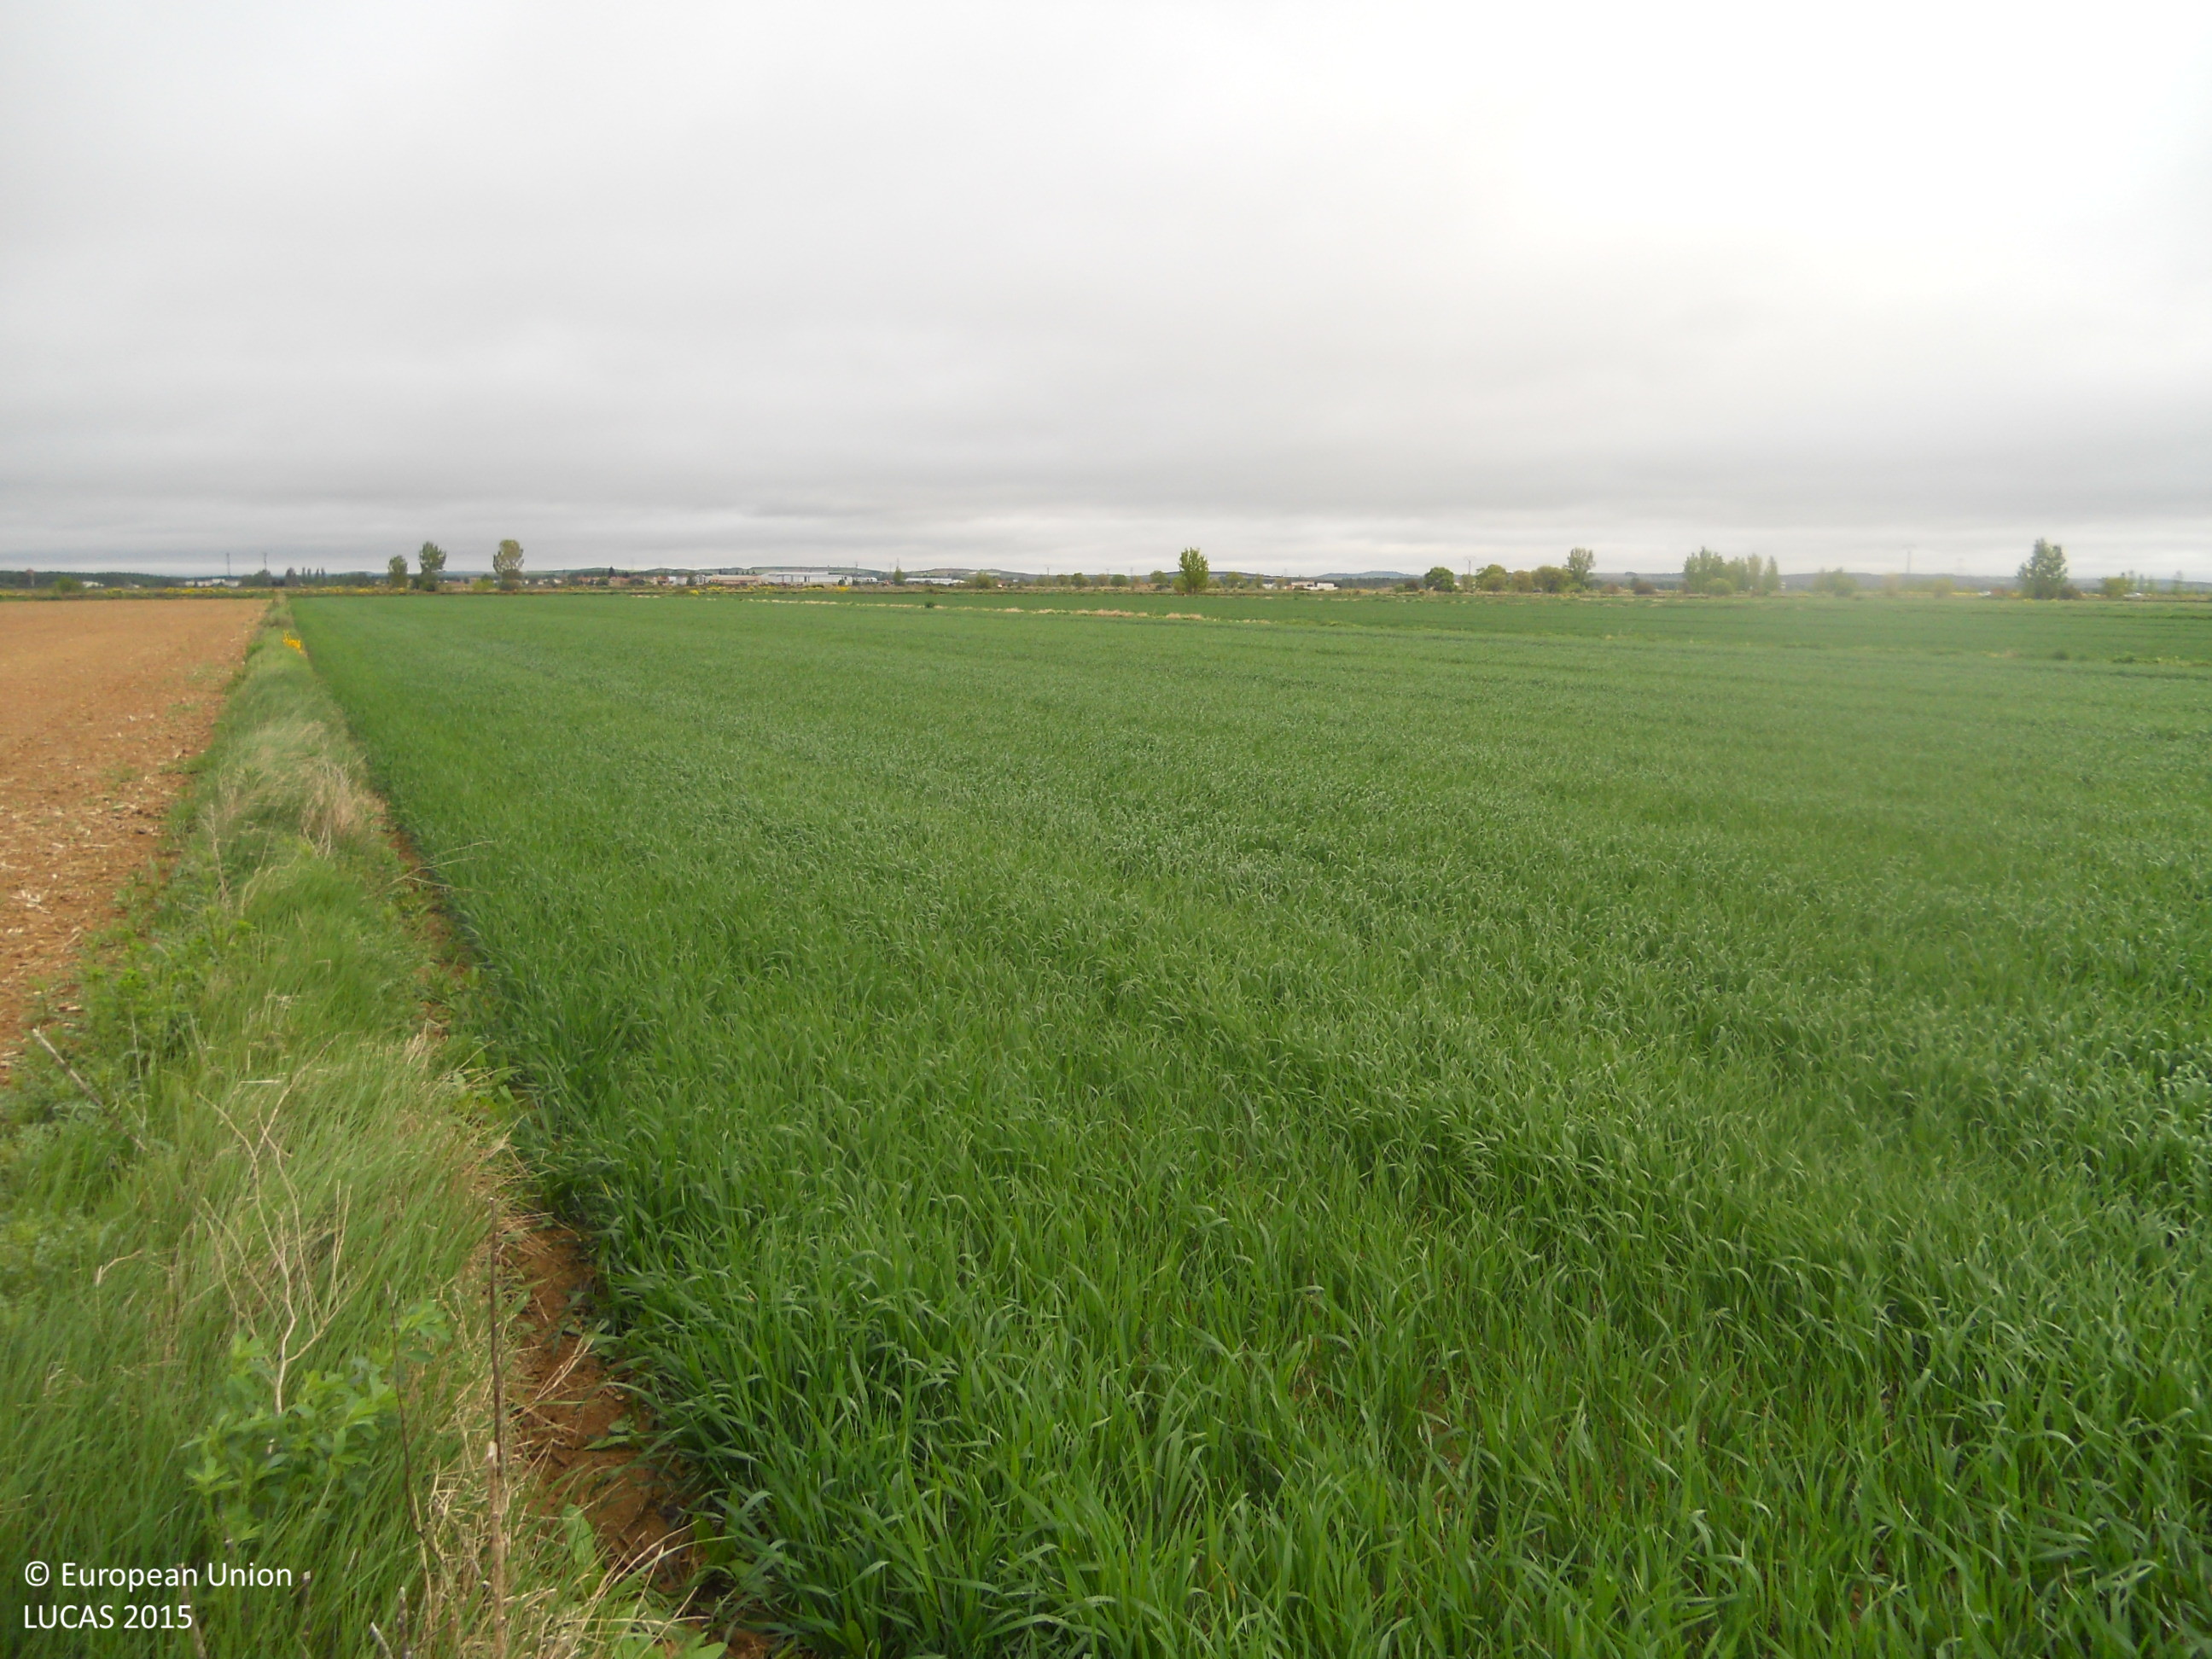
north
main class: Cropland
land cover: Common wheat
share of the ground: > 75 %
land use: Agriculture (excluding fallow land and kitchen gardens)
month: May
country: ES
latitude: 42.4763
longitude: -5.4067
